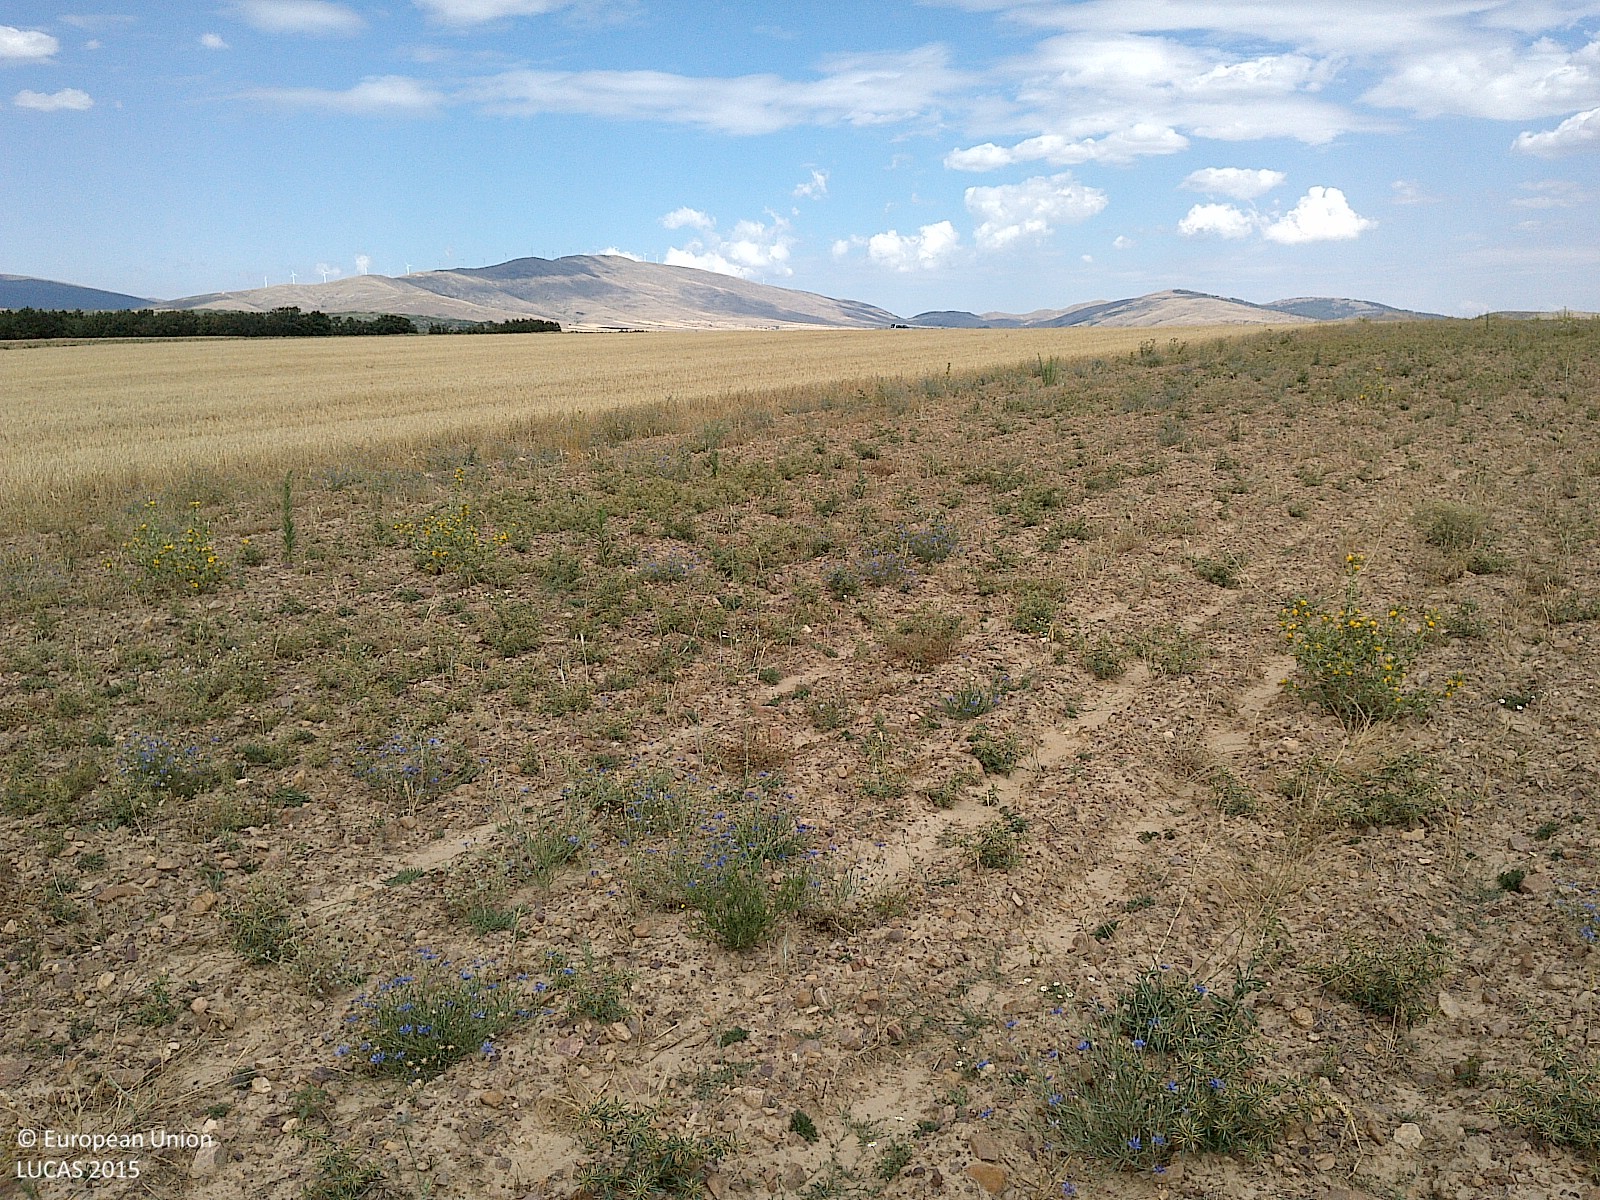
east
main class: Grassland
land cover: Spontaneously vegetated surfaces
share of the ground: 10 - 25 %
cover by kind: unconsolidated bare surface 85 %, herbaceous plants 15 %
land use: Fallow land
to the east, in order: Spontaneously vegetated surfaces; Common wheat; Other bare soil; Common wheat
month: July
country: ES
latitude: 41.6721
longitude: -1.9345
